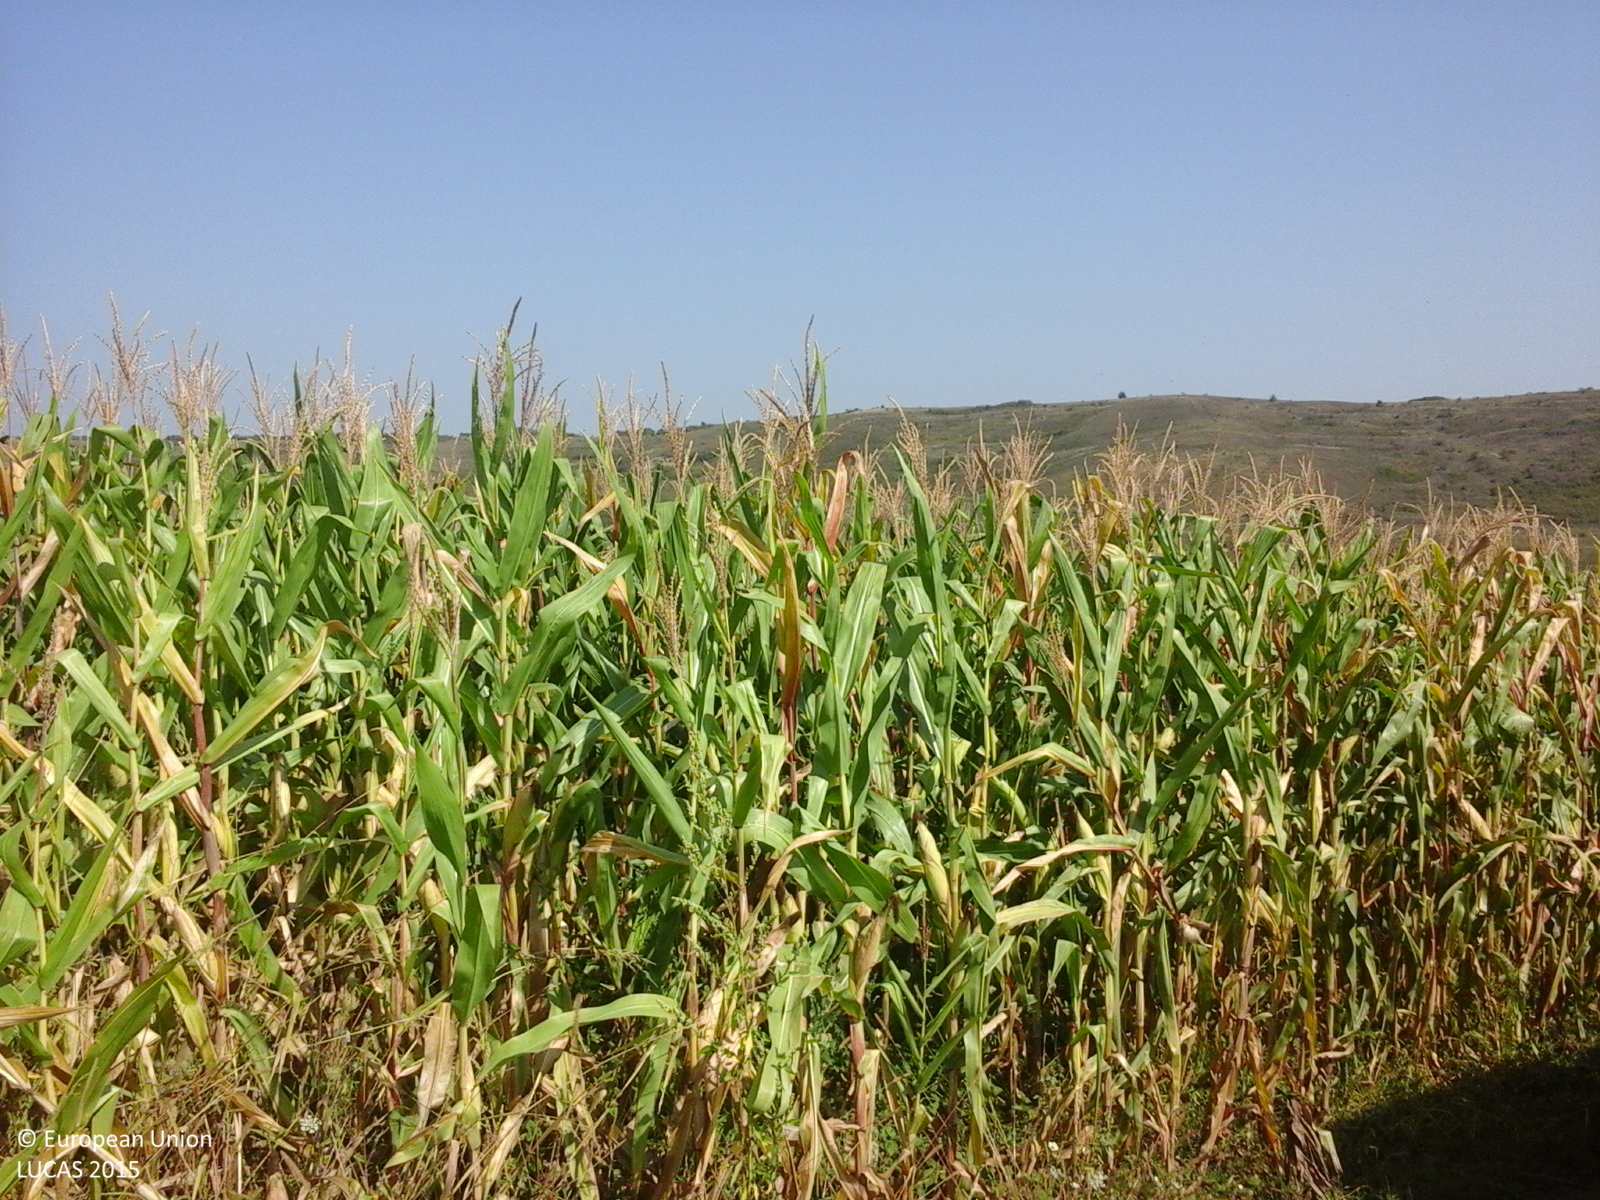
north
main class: Cropland
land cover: Maize
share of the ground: > 75 %
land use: Agriculture (excluding fallow land and kitchen gardens)
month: September
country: RO
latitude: 46.7498
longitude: 24.3405
